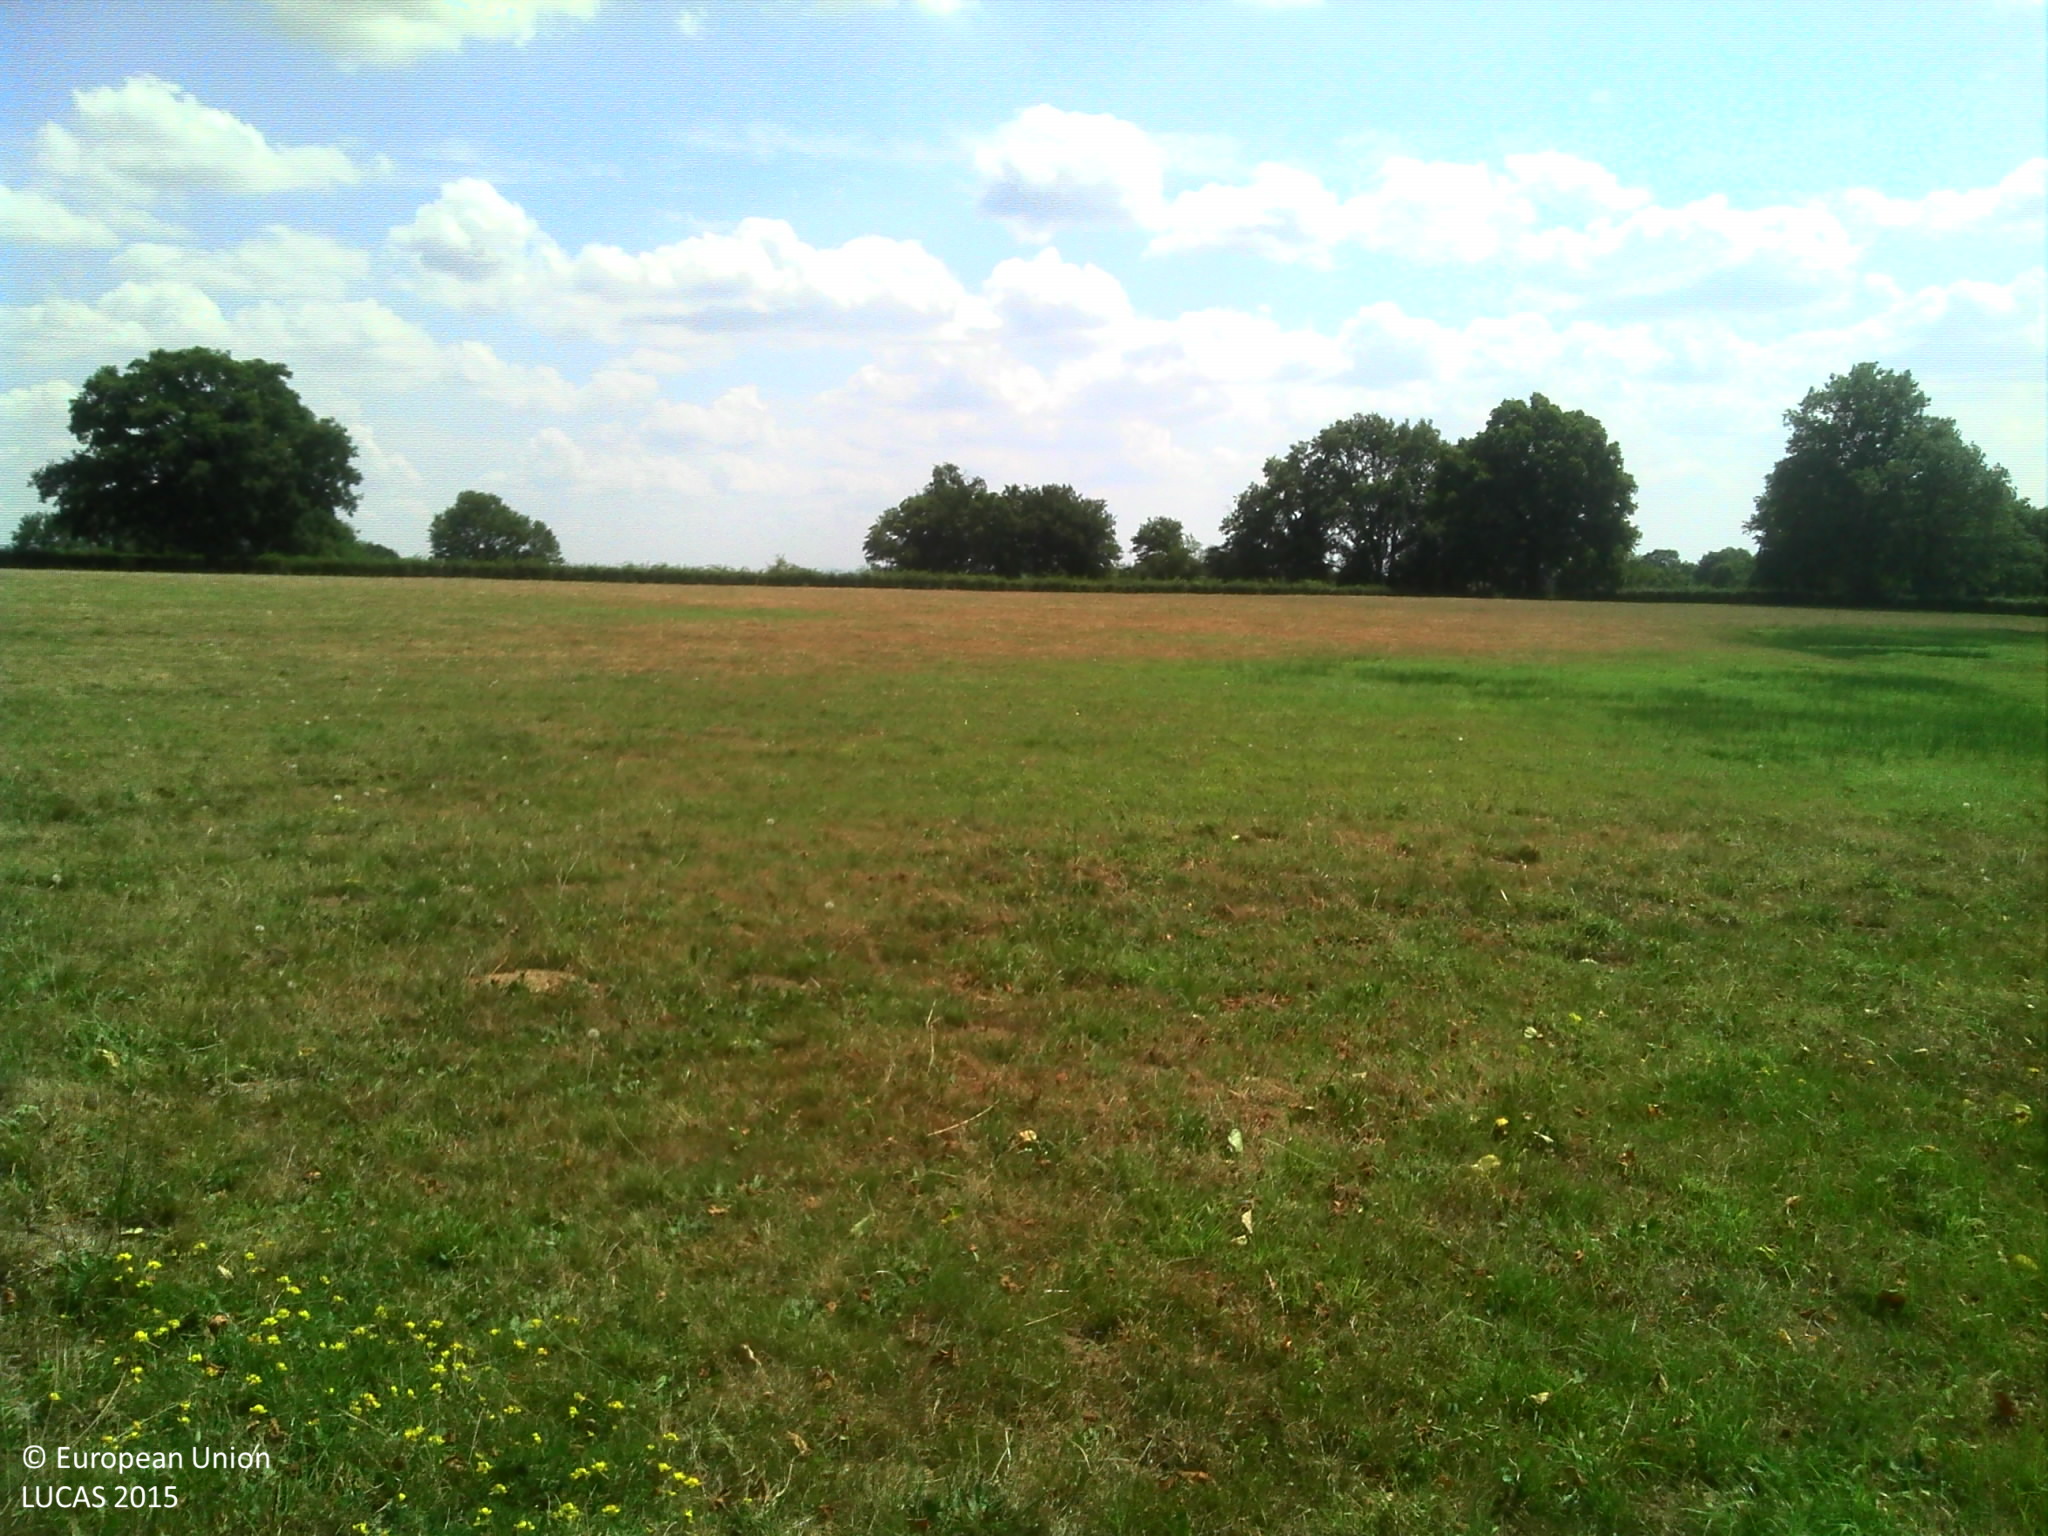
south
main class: Grassland
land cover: Grassland without tree/shrub cover
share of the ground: > 75 %
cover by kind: herbaceous plants 100 %
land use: Agriculture (excluding fallow land and kitchen gardens)
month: July
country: FR
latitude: 46.5644
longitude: 4.3783
